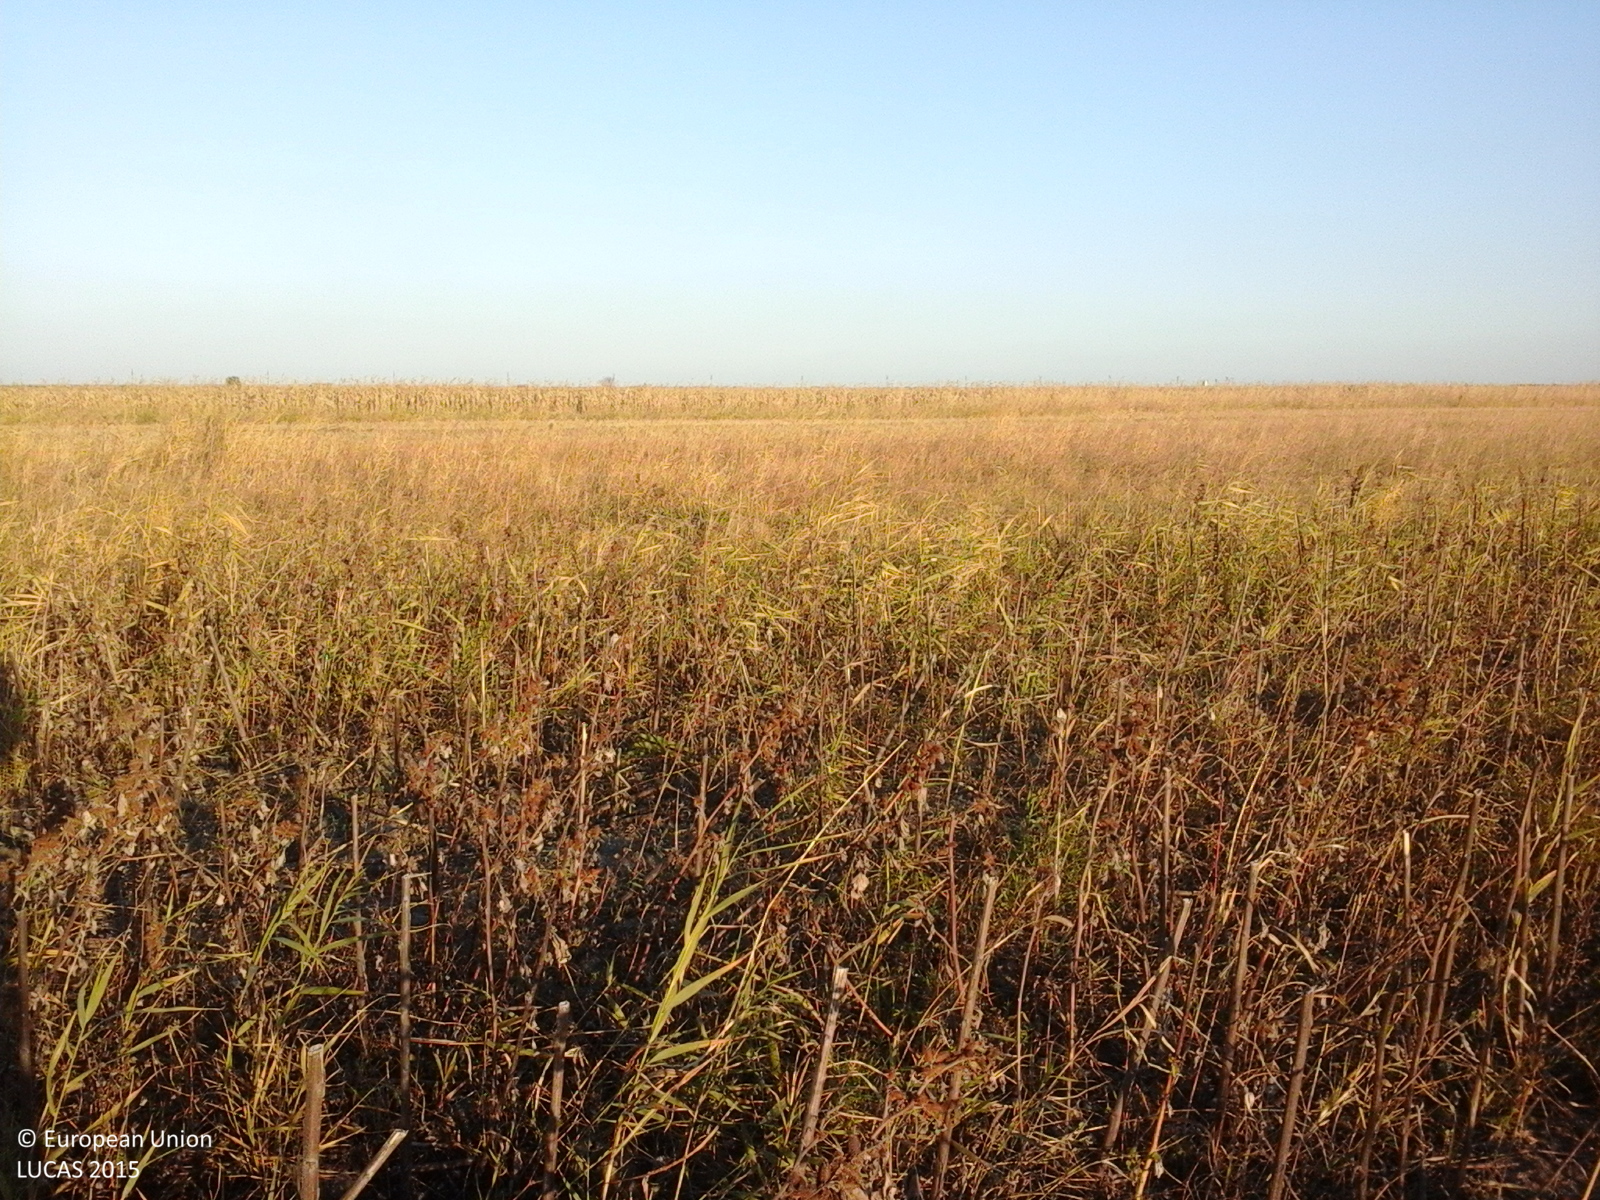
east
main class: Cropland
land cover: Sunflower
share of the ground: > 75 %
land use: Agriculture (excluding fallow land and kitchen gardens)
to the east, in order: Sunflower; Grassland without tree/shrub cover; Maize; Temporary grasslands
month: October
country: RO
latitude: 45.3977
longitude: 27.4608
